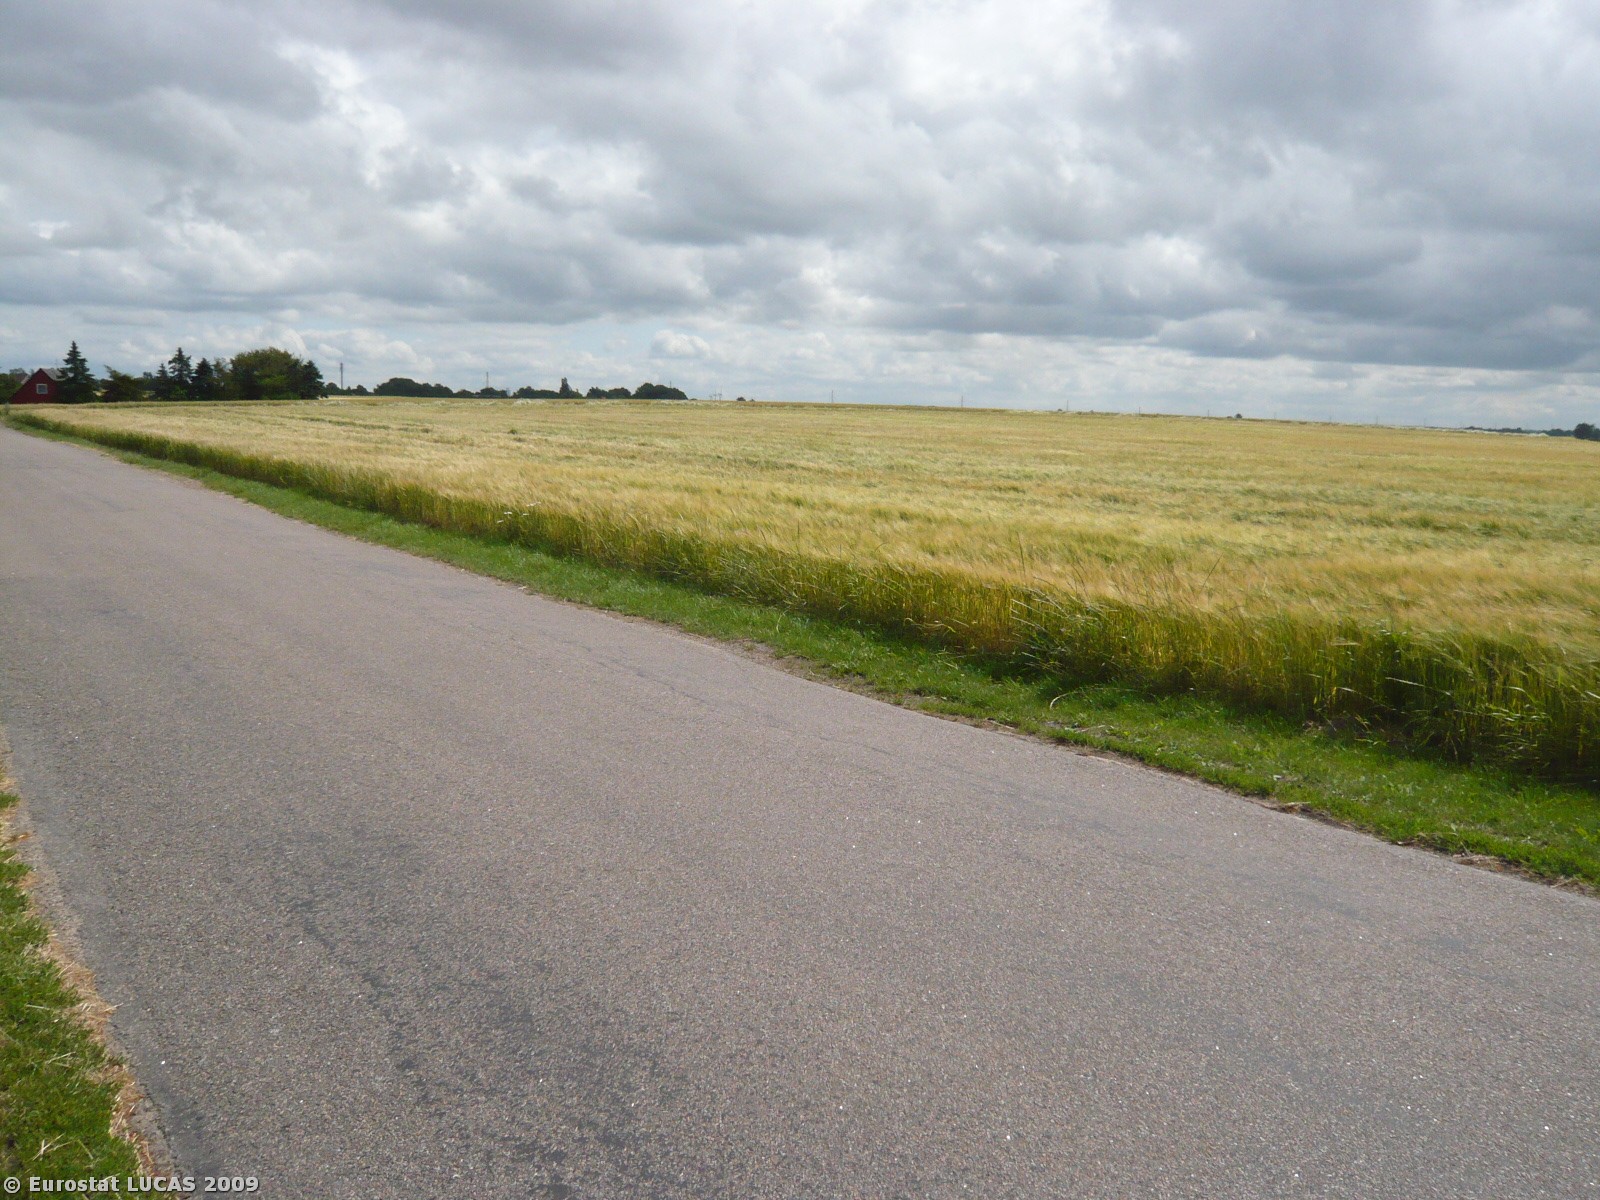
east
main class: Grassland
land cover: Grassland without tree/shrub cover
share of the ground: > 75 %
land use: Agriculture (excluding fallow land and kitchen gardens)
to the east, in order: Grassland without tree/shrub cover; Electric lines; Grassland without tree/shrub cover; Fences; Artificial constructions in urban areas; Paved roads, cycling and walking lanes; Grass margins; Common wheat; Mixed woodland; Artificial constructions in urban areas
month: July
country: DK
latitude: 55.6073
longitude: 11.1577
